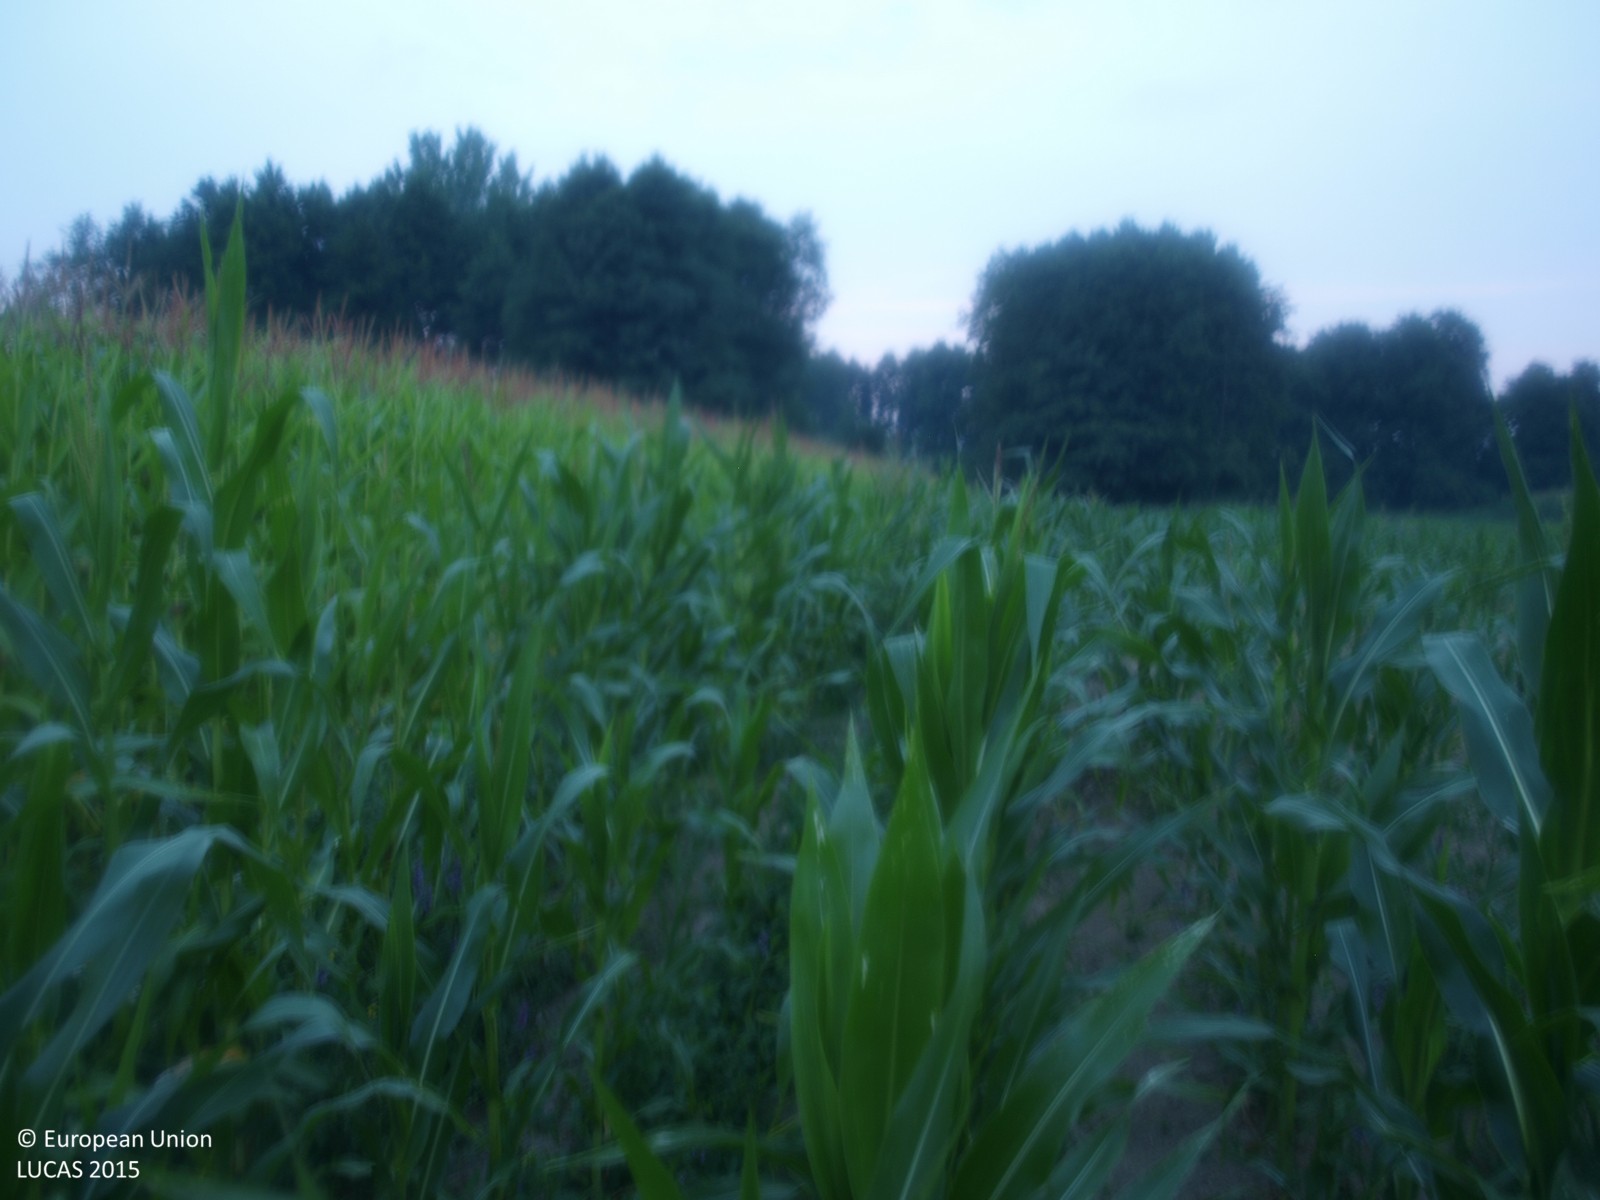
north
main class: Cropland
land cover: Maize
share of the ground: > 75 %
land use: Agriculture (excluding fallow land and kitchen gardens)
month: July
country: HR
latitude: 46.2407
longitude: 16.5498
